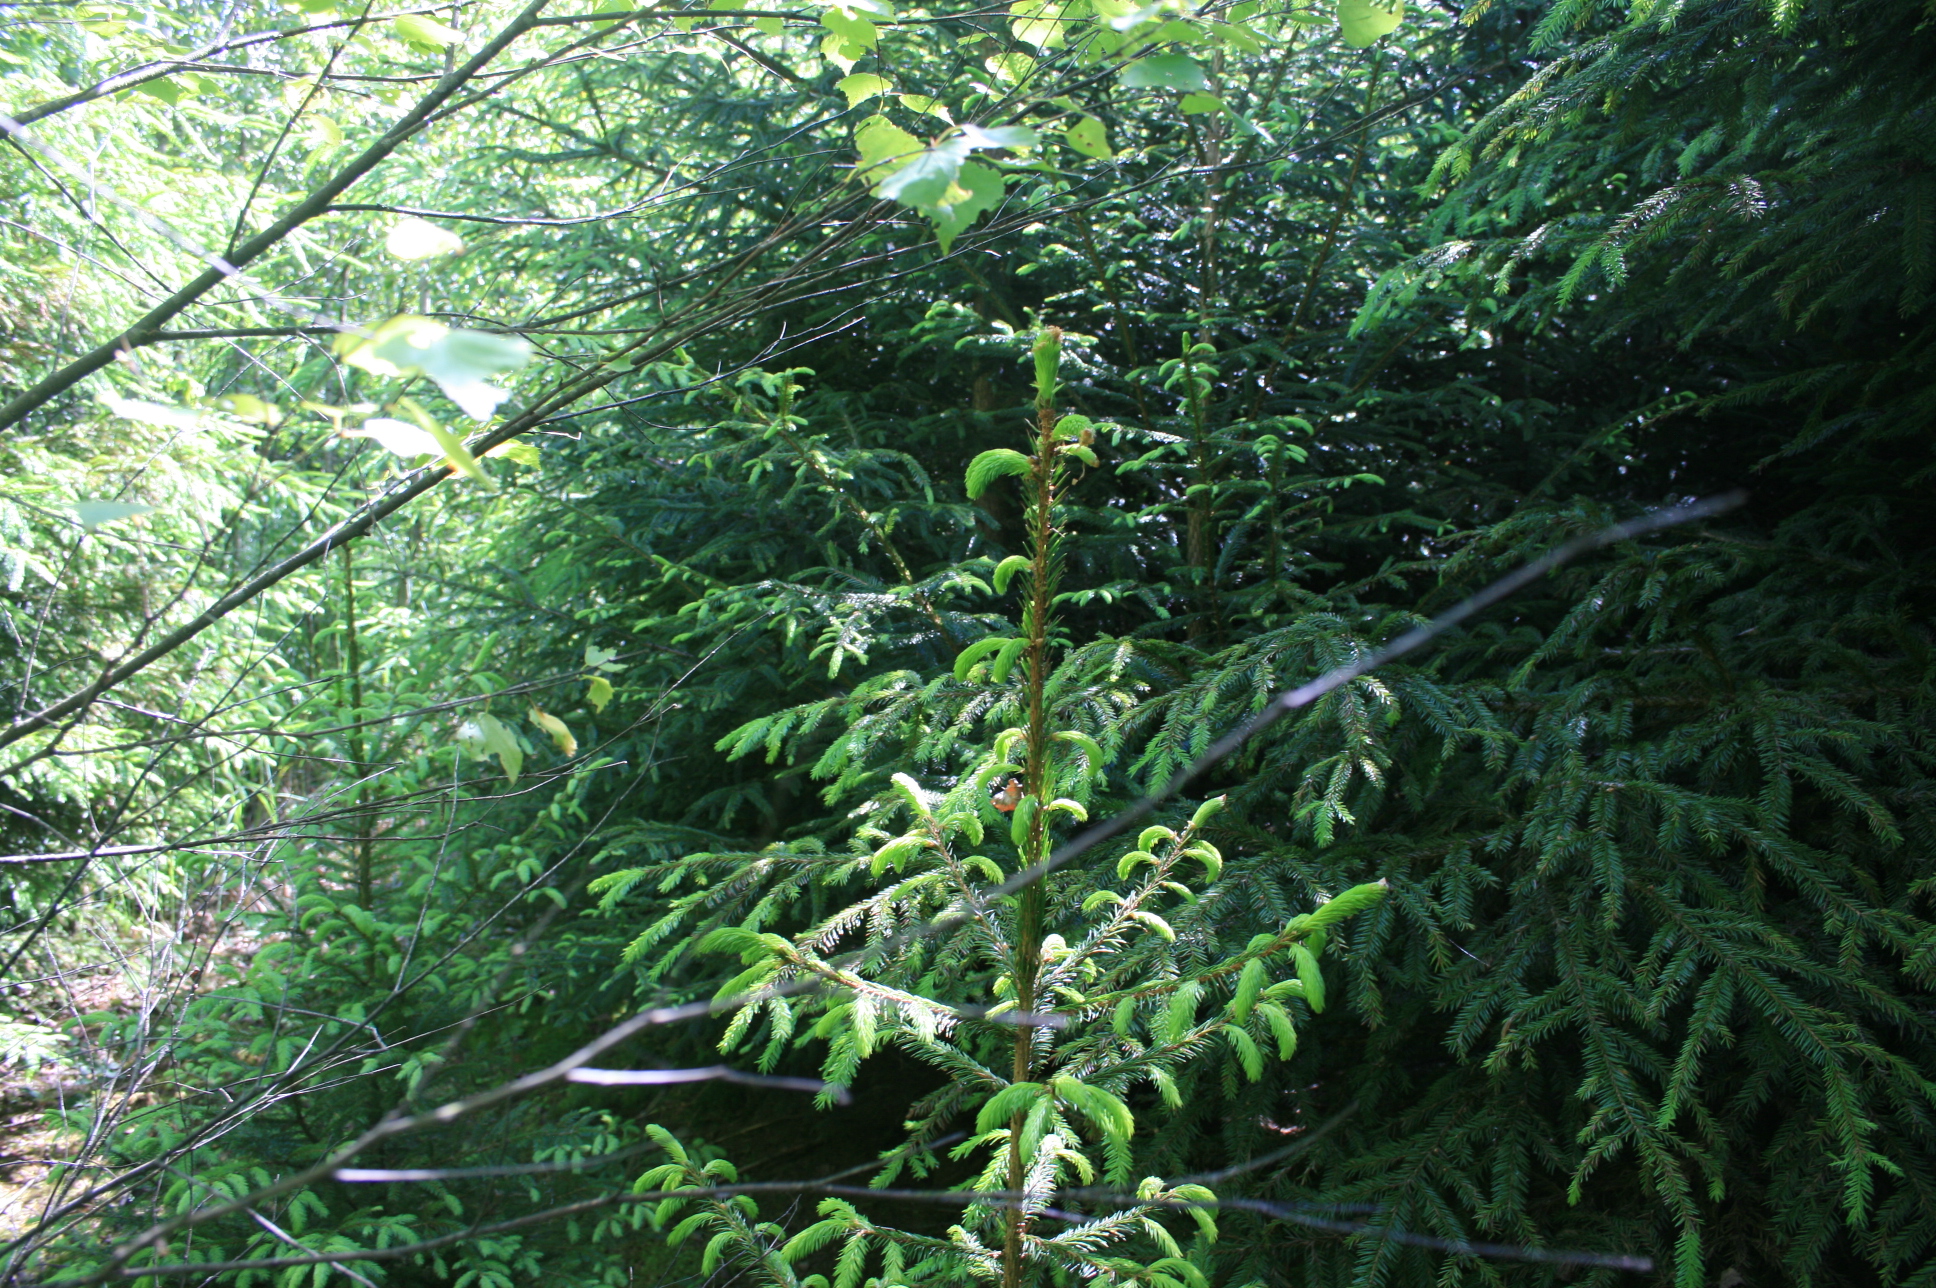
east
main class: Woodland
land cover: Spruce dominated coniferous woodland
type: hemiboreal forest and nemoral coniferous forest and mixed broadleaved-coniferous forest
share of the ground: > 75 %
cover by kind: coniferous forest trees 80 %, broadleaved forest trees 20 %
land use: Forestry
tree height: < 5 m
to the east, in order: Spruce dominated coniferous woodland; Spontaneously vegetated surfaces; Paved roads, cycling and walking lanes; Spontaneously vegetated surfaces; Other mixed woodland; Spruce dominated mixed woodland; Tracks; Spruce dominated mixed woodland; Electric lines; Broadleaved woodland
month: June
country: LT
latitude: 55.4587
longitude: 22.1855
